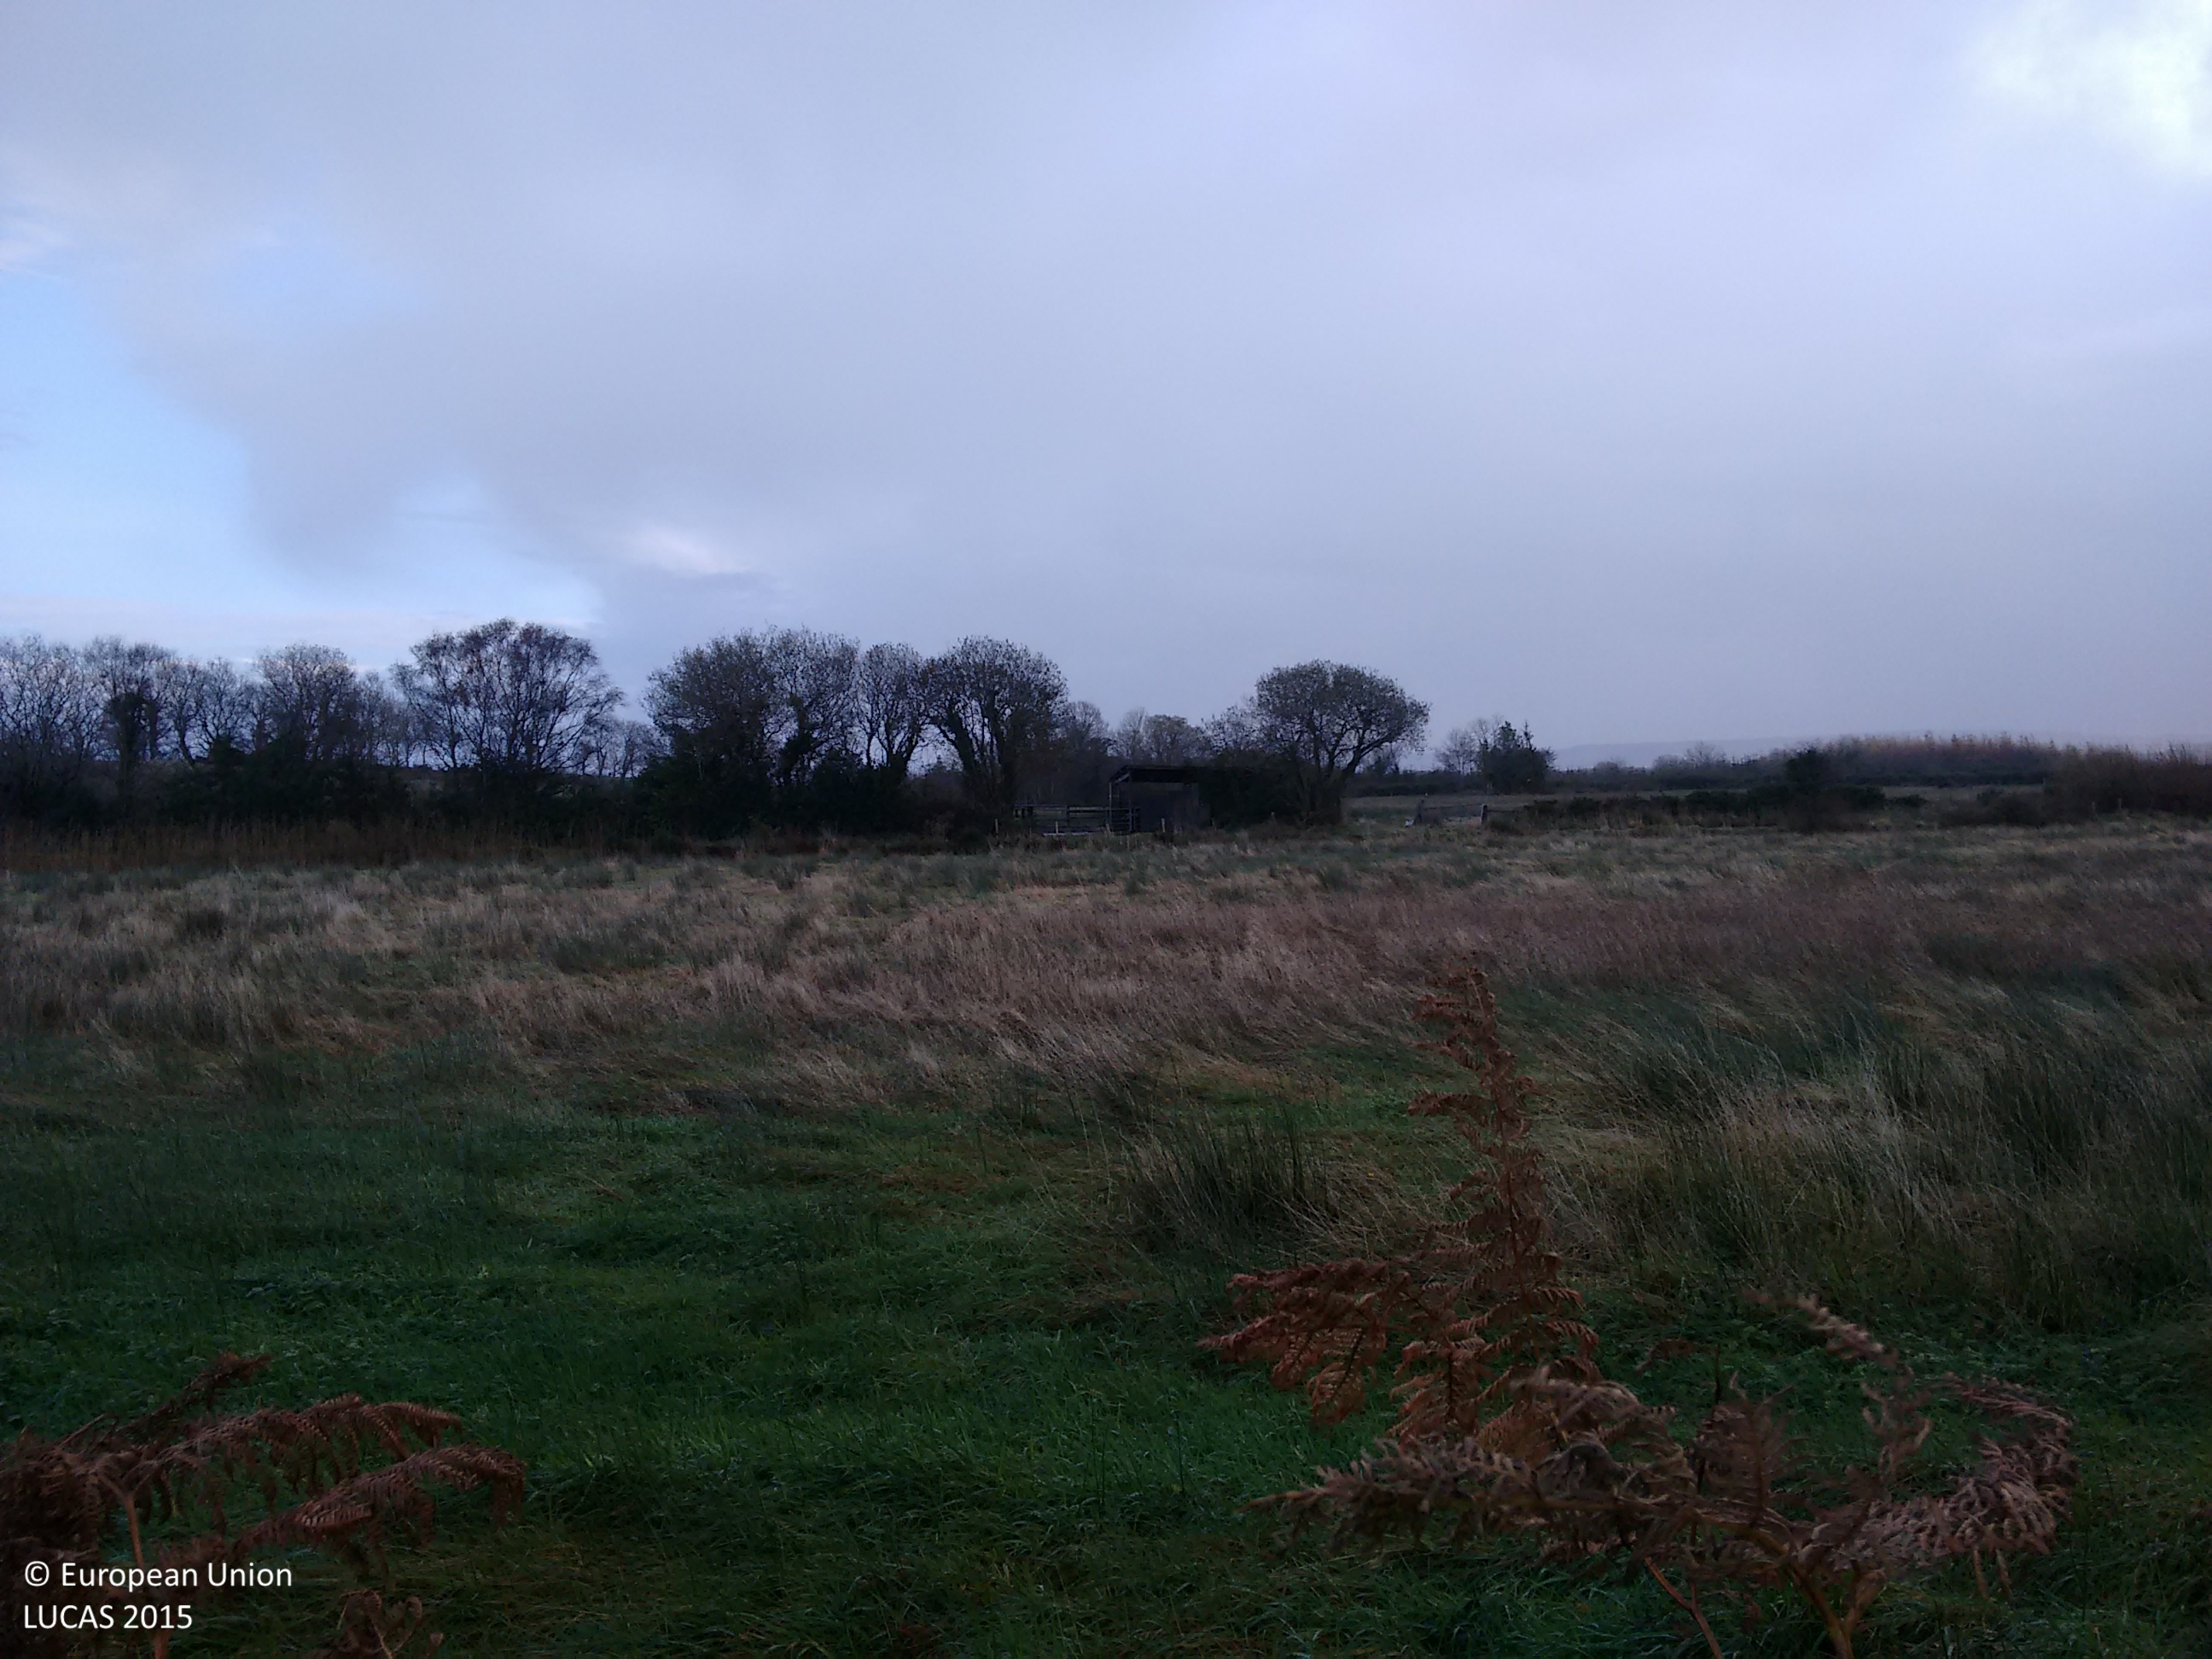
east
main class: Grassland
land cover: Grassland without tree/shrub cover
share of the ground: > 75 %
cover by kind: herbaceous plants 100 %
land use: Agriculture (excluding fallow land and kitchen gardens)
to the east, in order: Grassland without tree/shrub cover; Ditches and canals; Artificial constructions in urban areas; Grassland without tree/shrub cover; Fences; Grassland without tree/shrub cover; Fences; Lines of trees; Abandoned hedges; Grassland without tree/shrub cover; Ditches and canals; Grassland without tree/shrub cover; Abandoned hedges; Grassland without tree/shrub cover
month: November
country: IE
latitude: 54.4732
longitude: -8.1240
